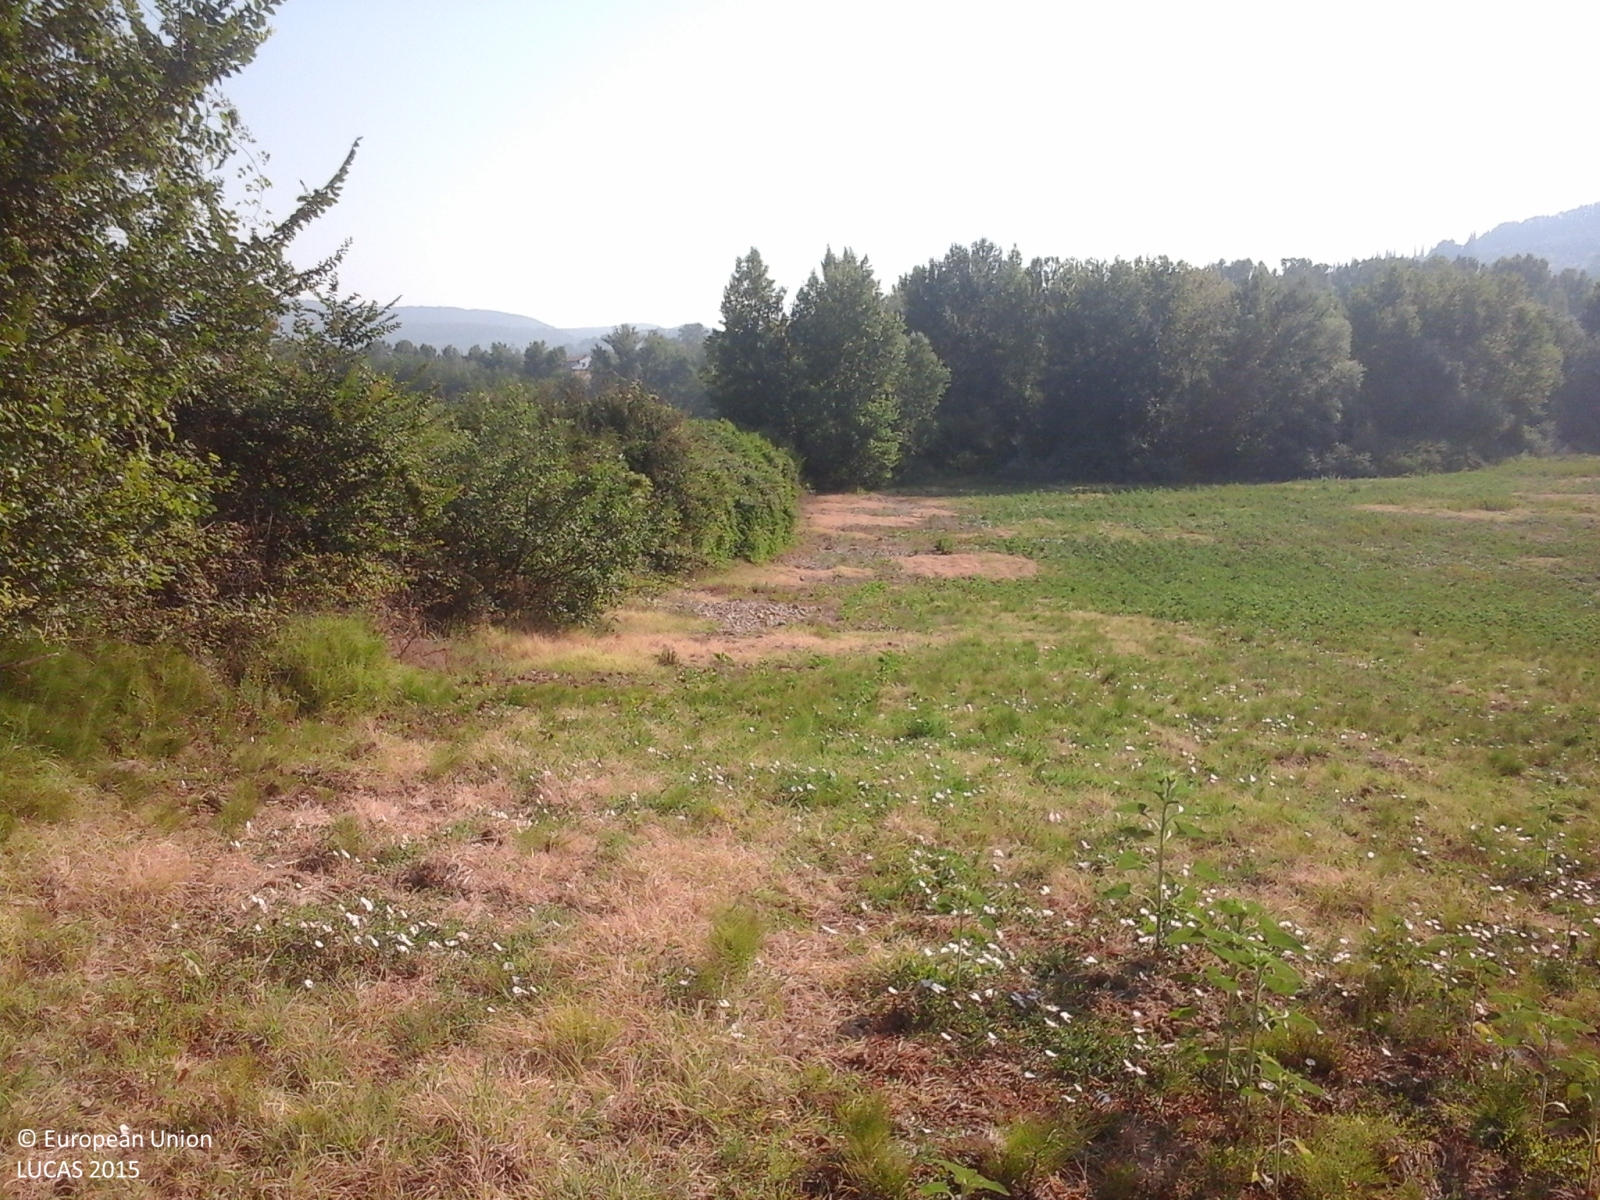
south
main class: Cropland
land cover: Sunflower
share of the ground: > 75 %
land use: Agriculture (excluding fallow land and kitchen gardens)
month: July
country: IT
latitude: 43.6769
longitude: 11.1257
